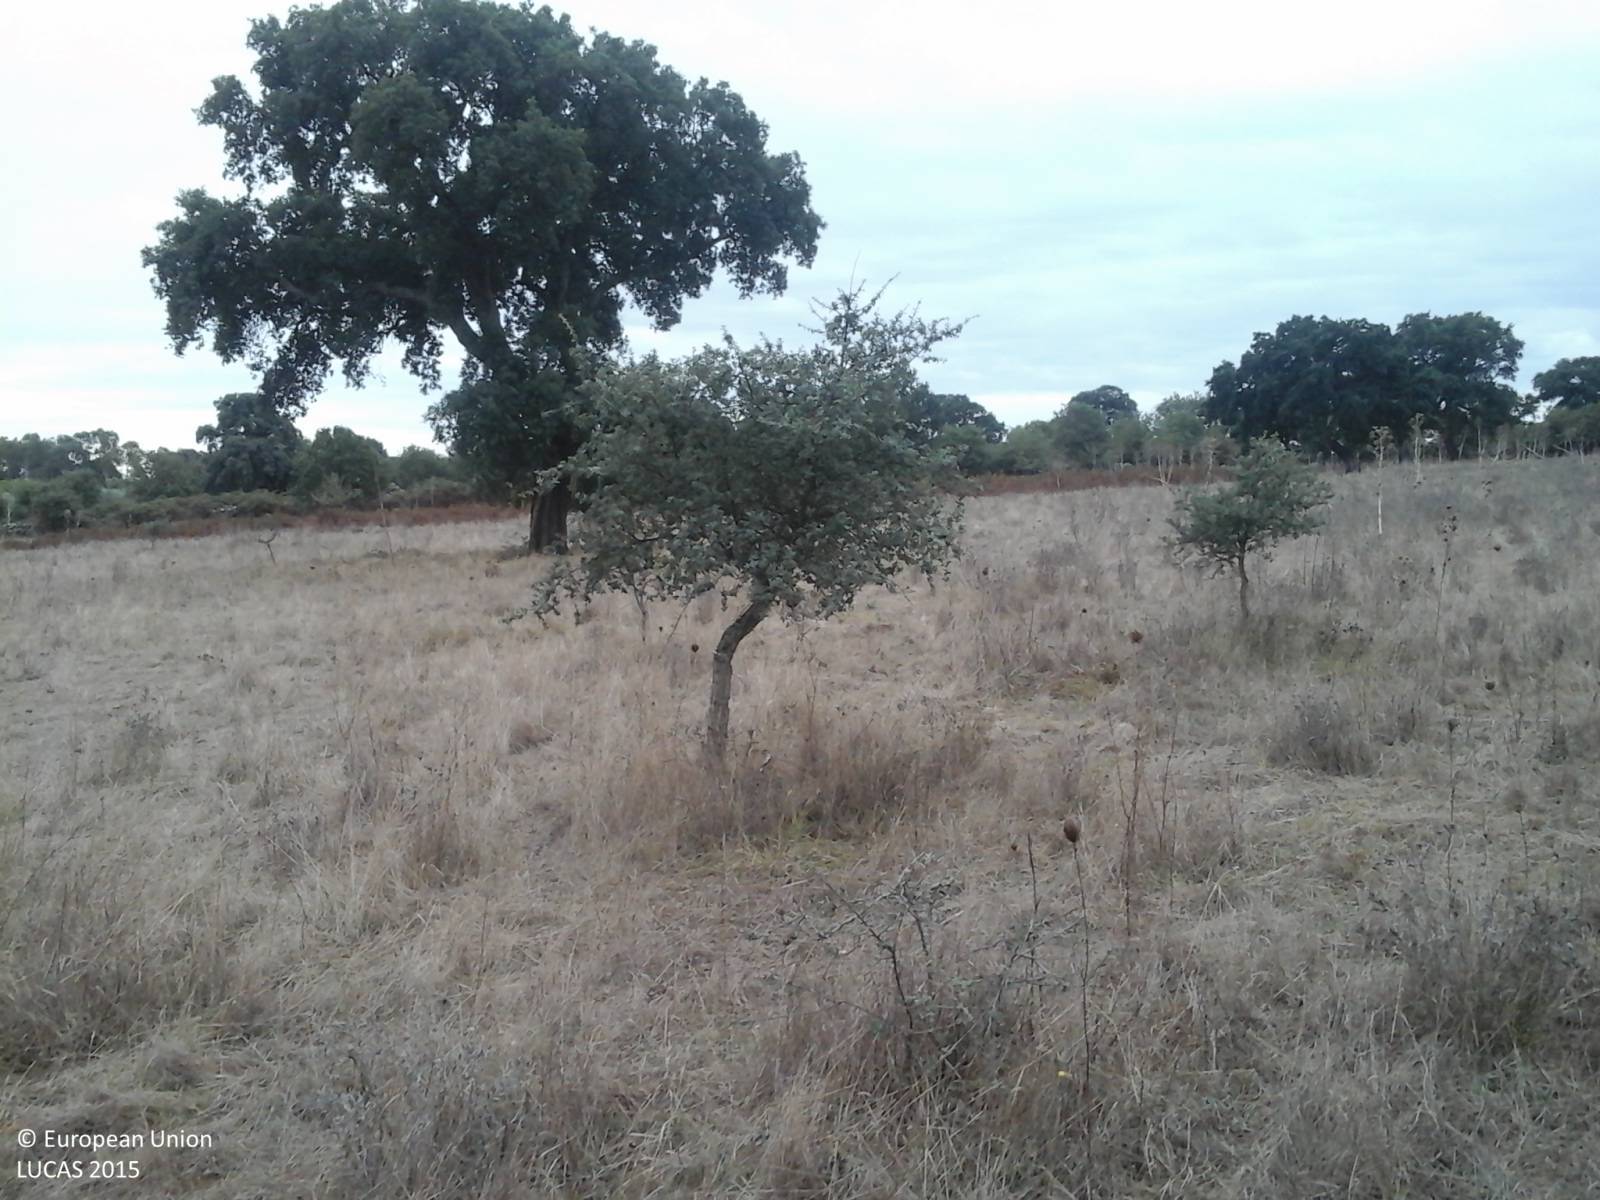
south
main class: Grassland
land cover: Grassland with sparse tree/shrub cover
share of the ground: > 75 %
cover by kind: herbaceous plants 95 %, broadleaved forest trees 5 %
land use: Agriculture (excluding fallow land and kitchen gardens)
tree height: < 5 m
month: September
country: IT
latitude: 40.1694
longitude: 8.7969
